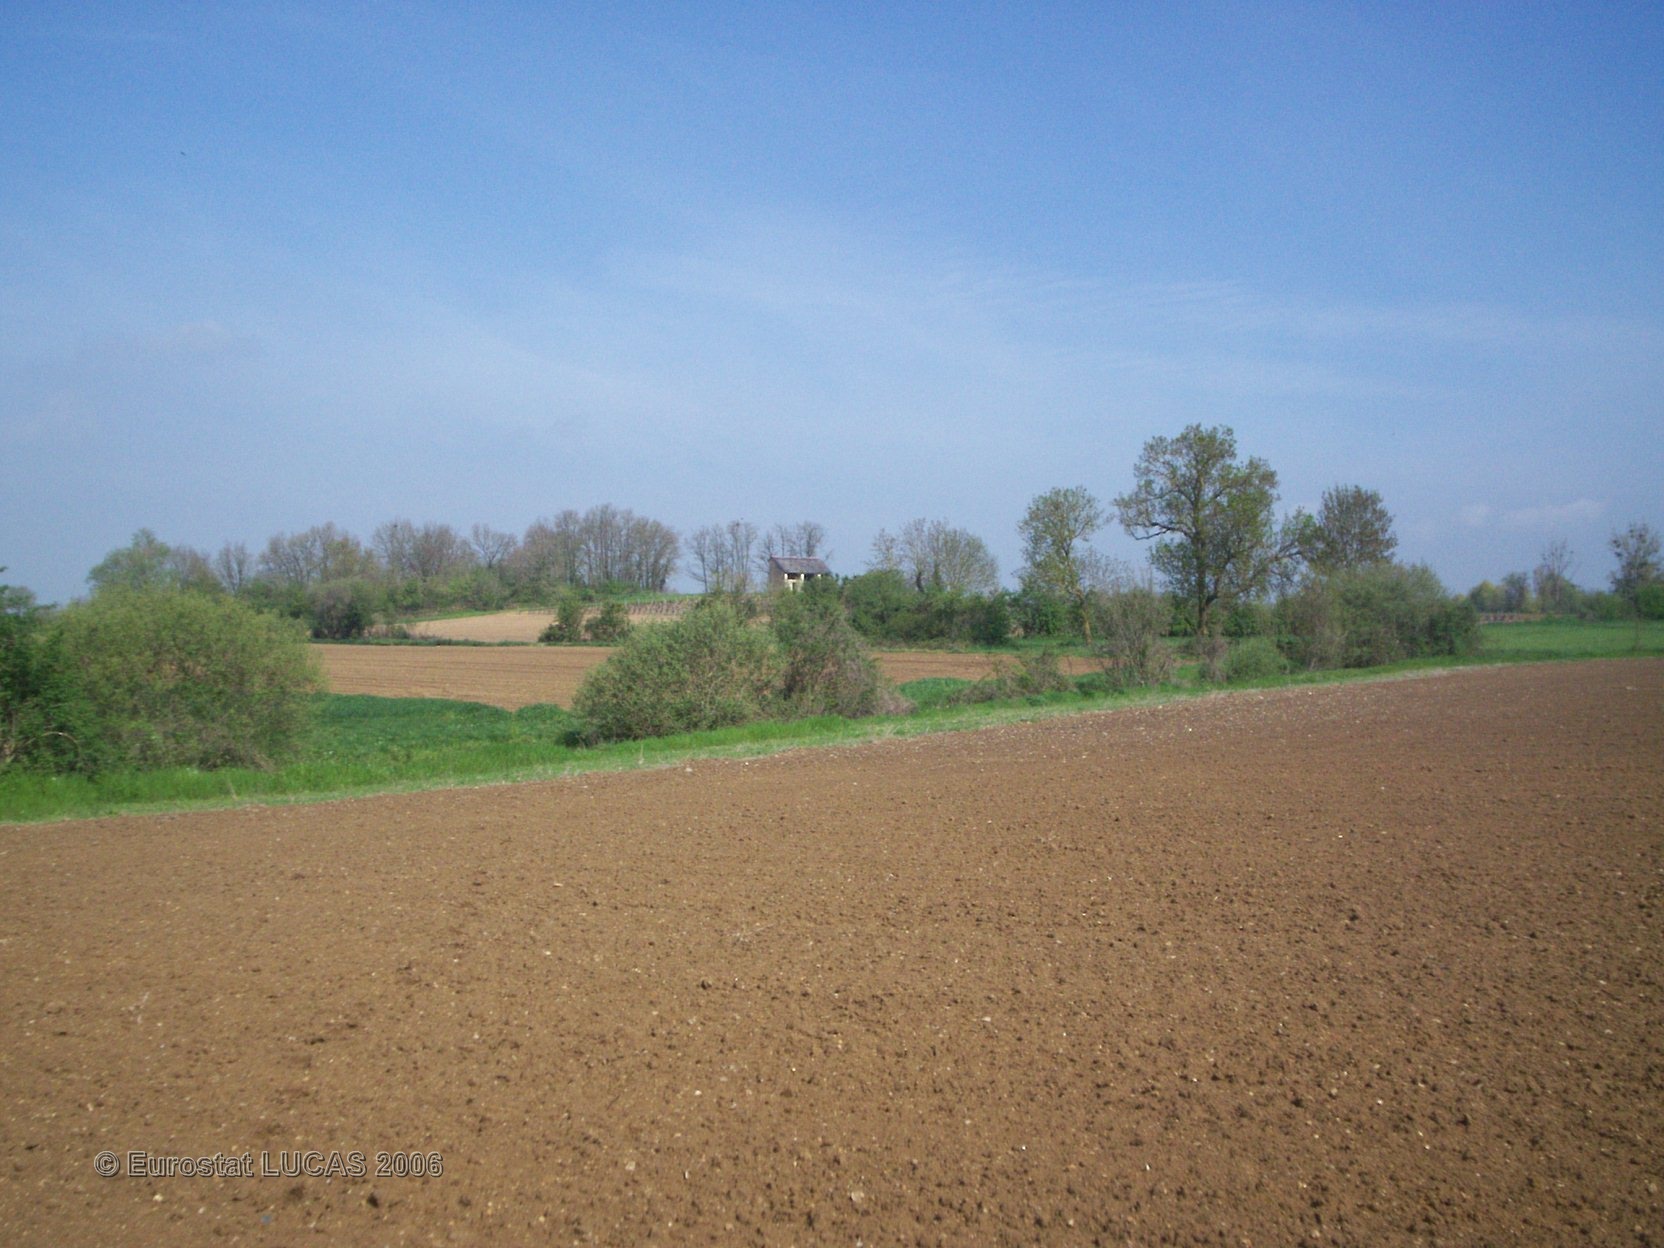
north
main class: Cropland
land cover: Sunflower
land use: Agriculture (excluding fallow land and kitchen gardens)
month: April
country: FR
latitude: 47.2430
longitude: -0.3728
